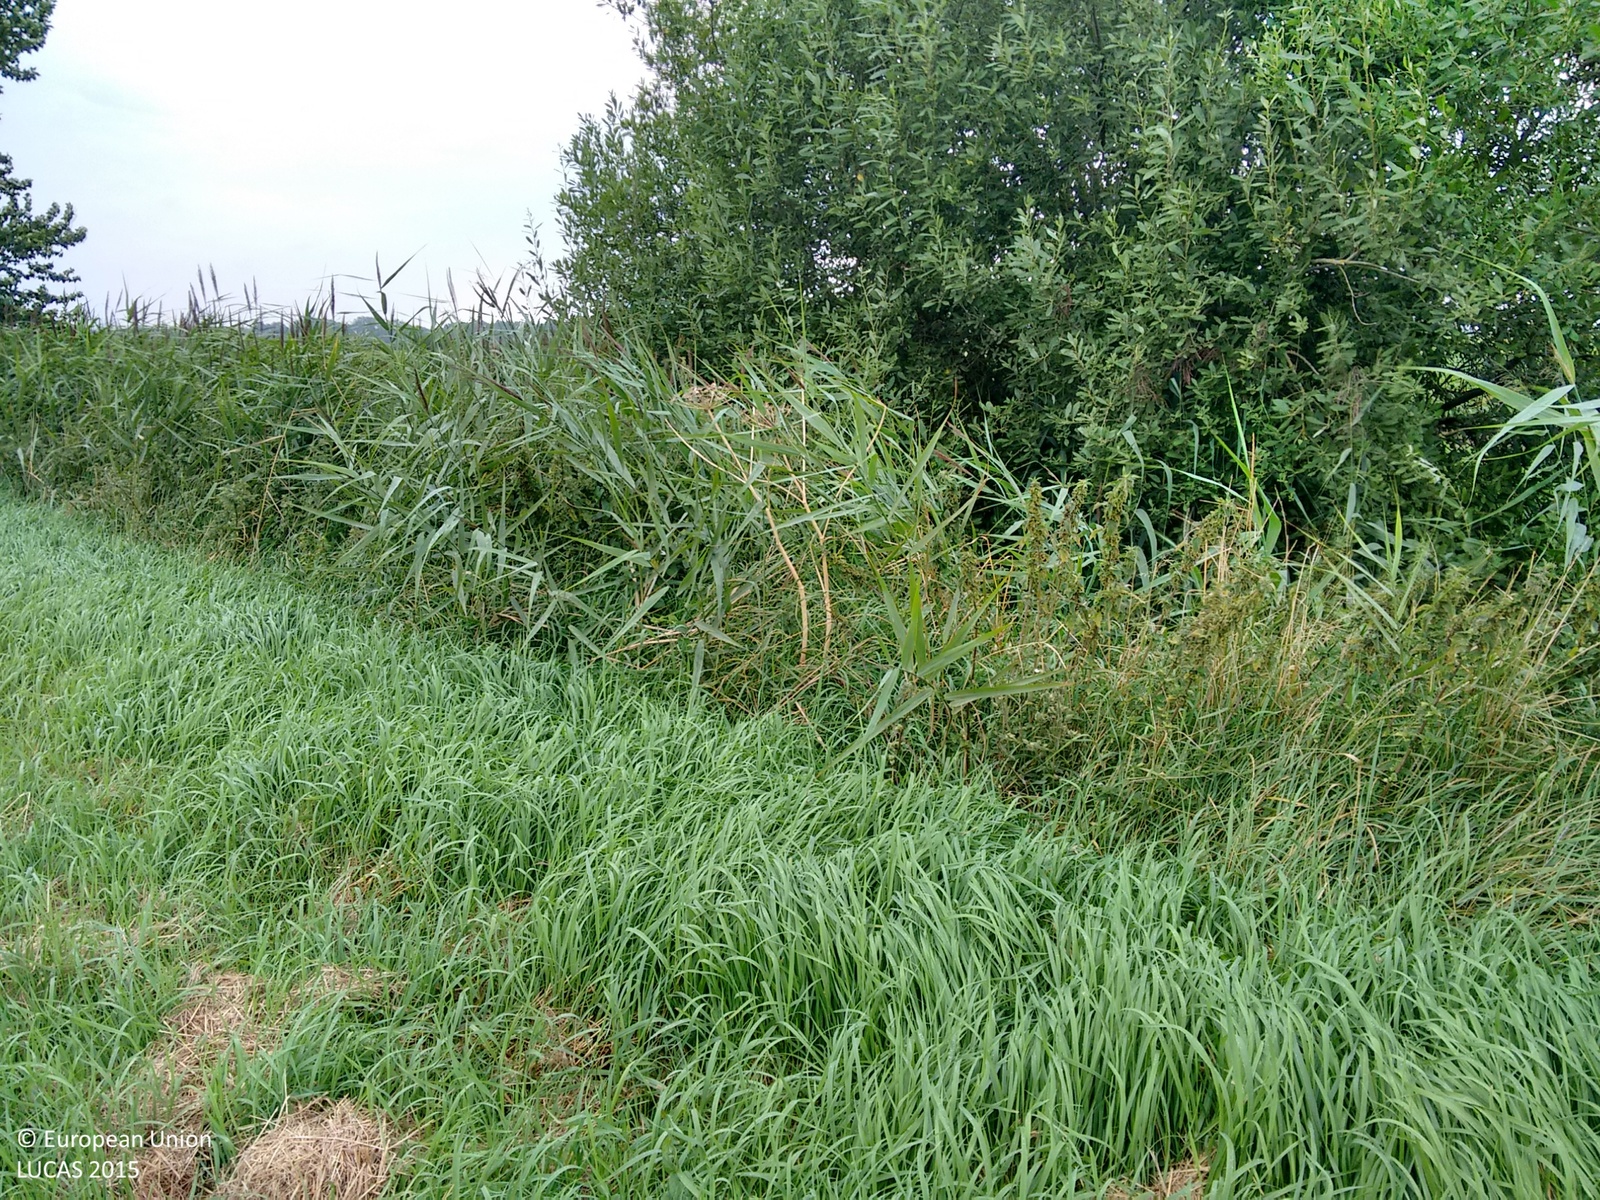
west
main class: Grassland
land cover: Grassland without tree/shrub cover
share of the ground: > 75 %
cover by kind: herbaceous plants 100 %
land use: Agriculture (excluding fallow land and kitchen gardens)
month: August
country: GB
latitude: 52.3841
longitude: 0.3773
